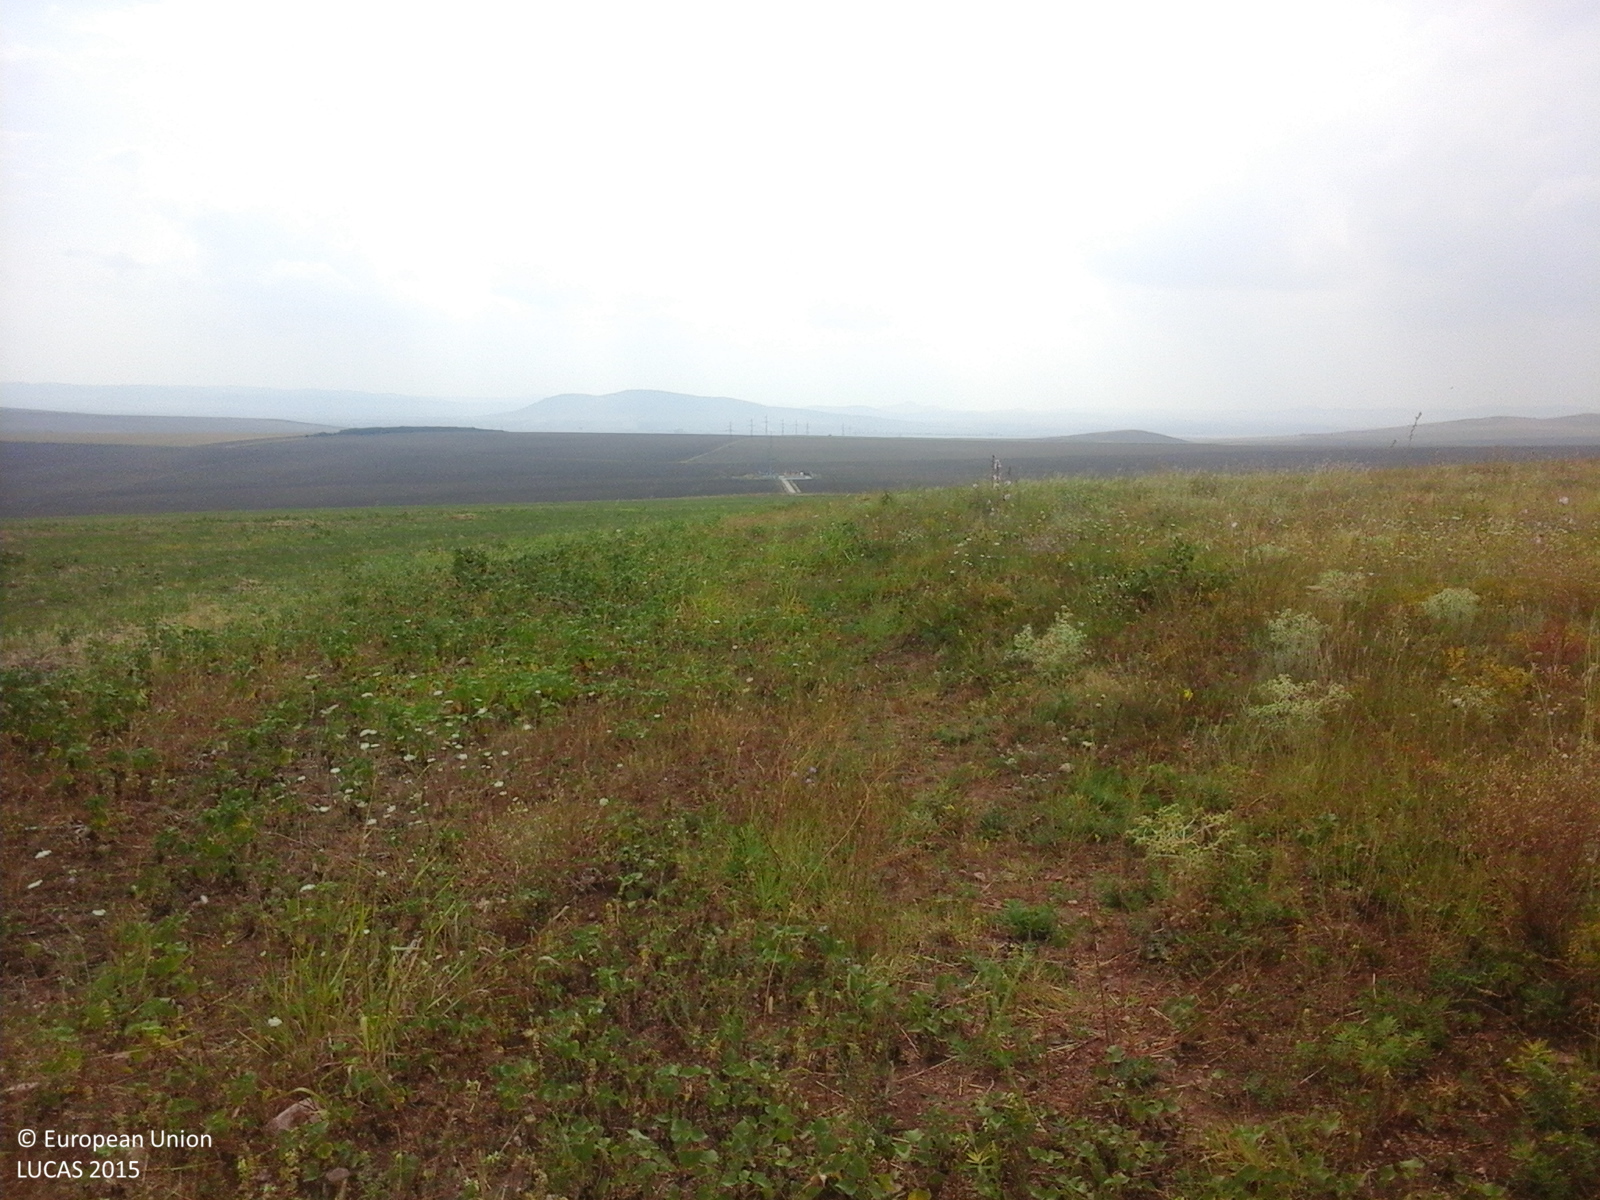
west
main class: Grassland
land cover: Spontaneously vegetated surfaces
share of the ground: 50 - 75 %
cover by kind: herbaceous plants 100 %
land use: Fallow land
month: July
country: RO
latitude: 45.0101
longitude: 28.8297
